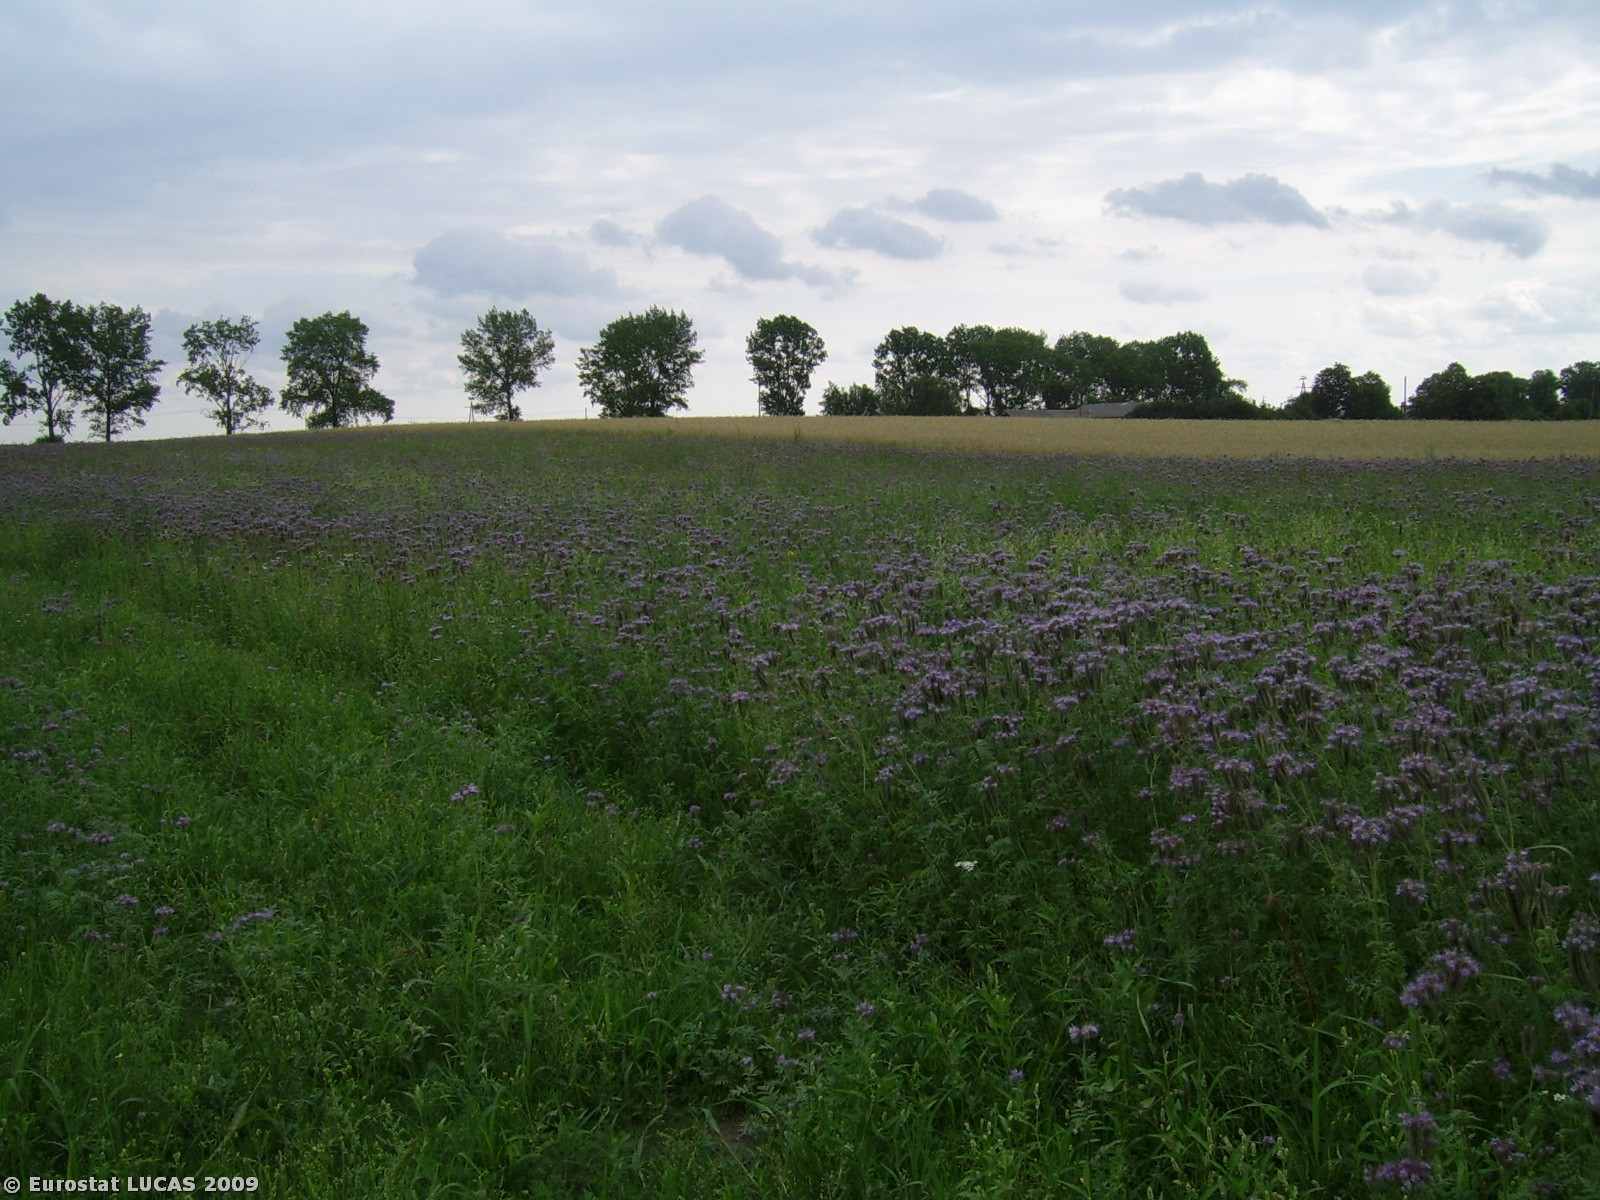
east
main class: Cropland
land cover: Other leguminous and mixtures for fodder
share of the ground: > 75 %
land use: Agriculture (excluding fallow land and kitchen gardens)
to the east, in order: Other leguminous and mixtures for fodder; Triticale; Grass margins; Barley
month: July
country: PL
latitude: 53.2471
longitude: 18.2442
